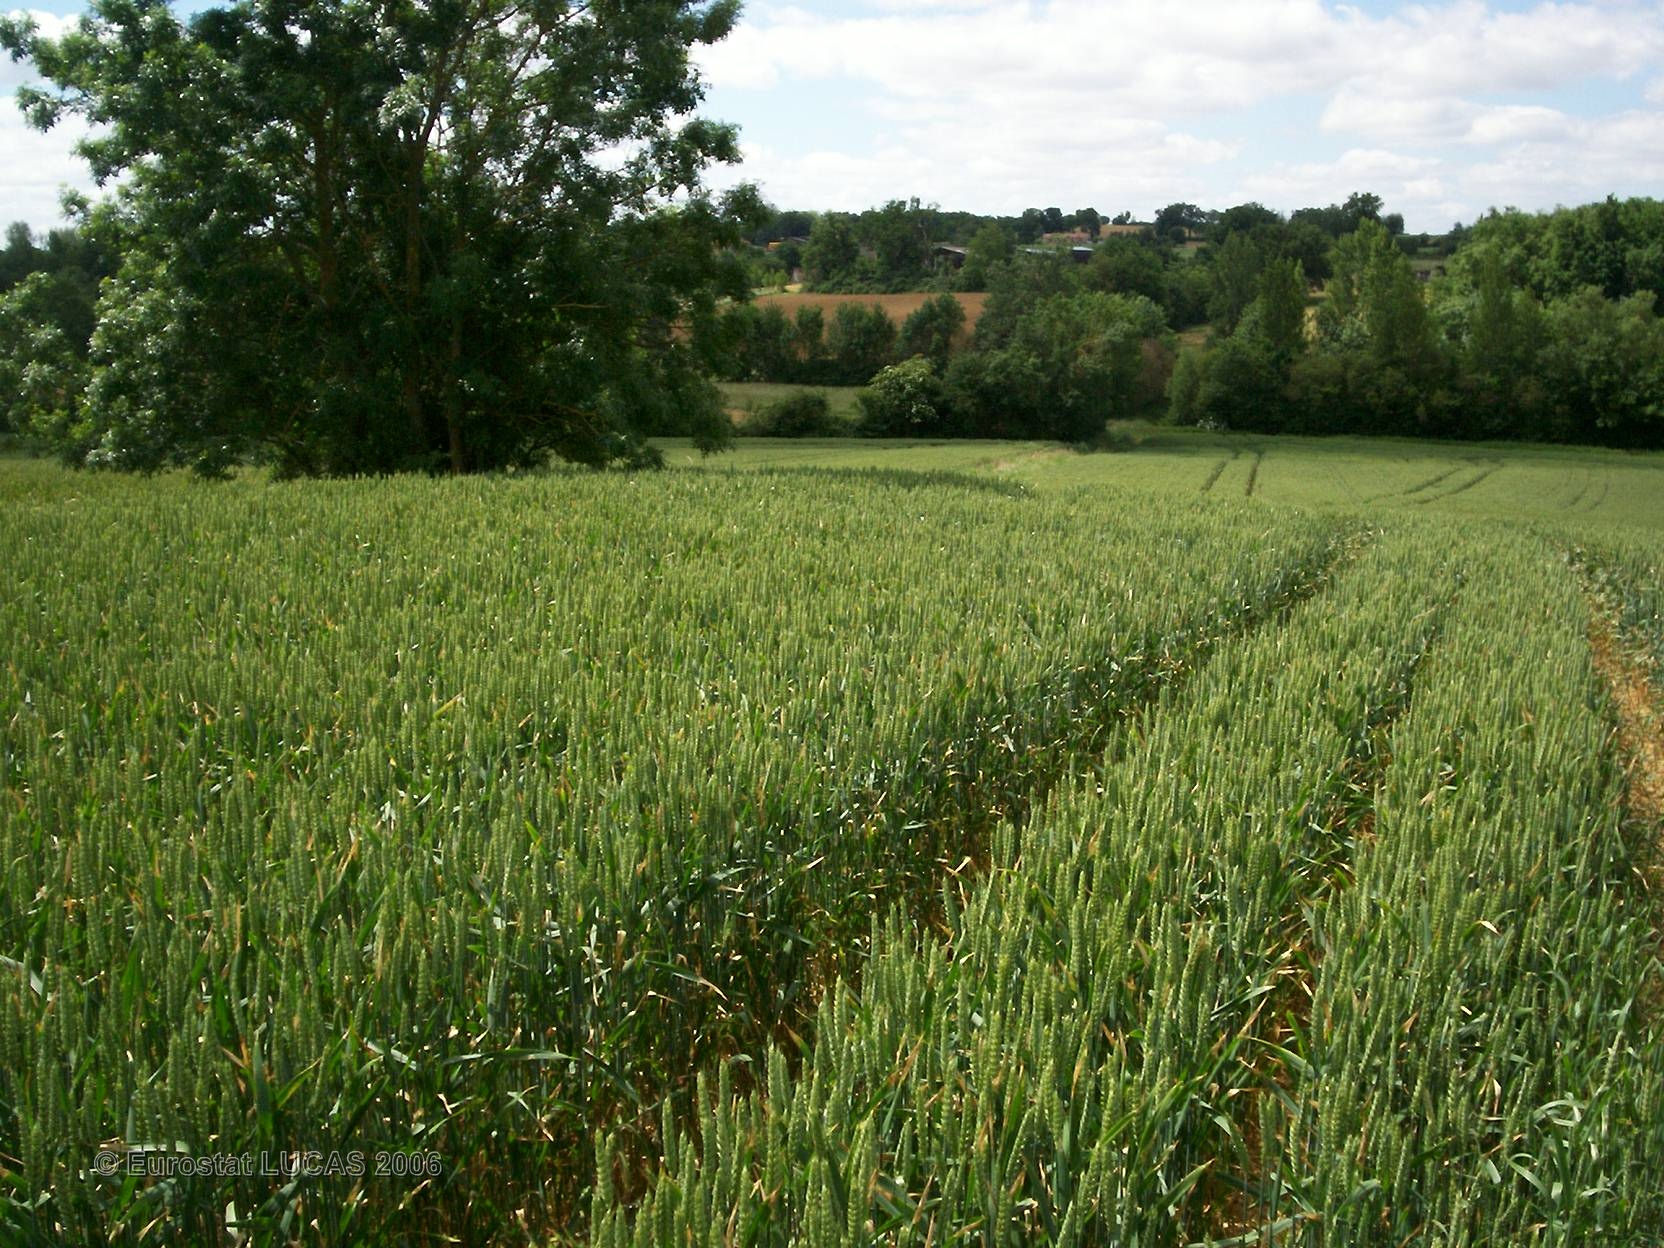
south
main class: Cropland
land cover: Common wheat
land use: Agriculture (excluding fallow land and kitchen gardens)
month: May
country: FR
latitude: 43.6492
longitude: 0.9866
